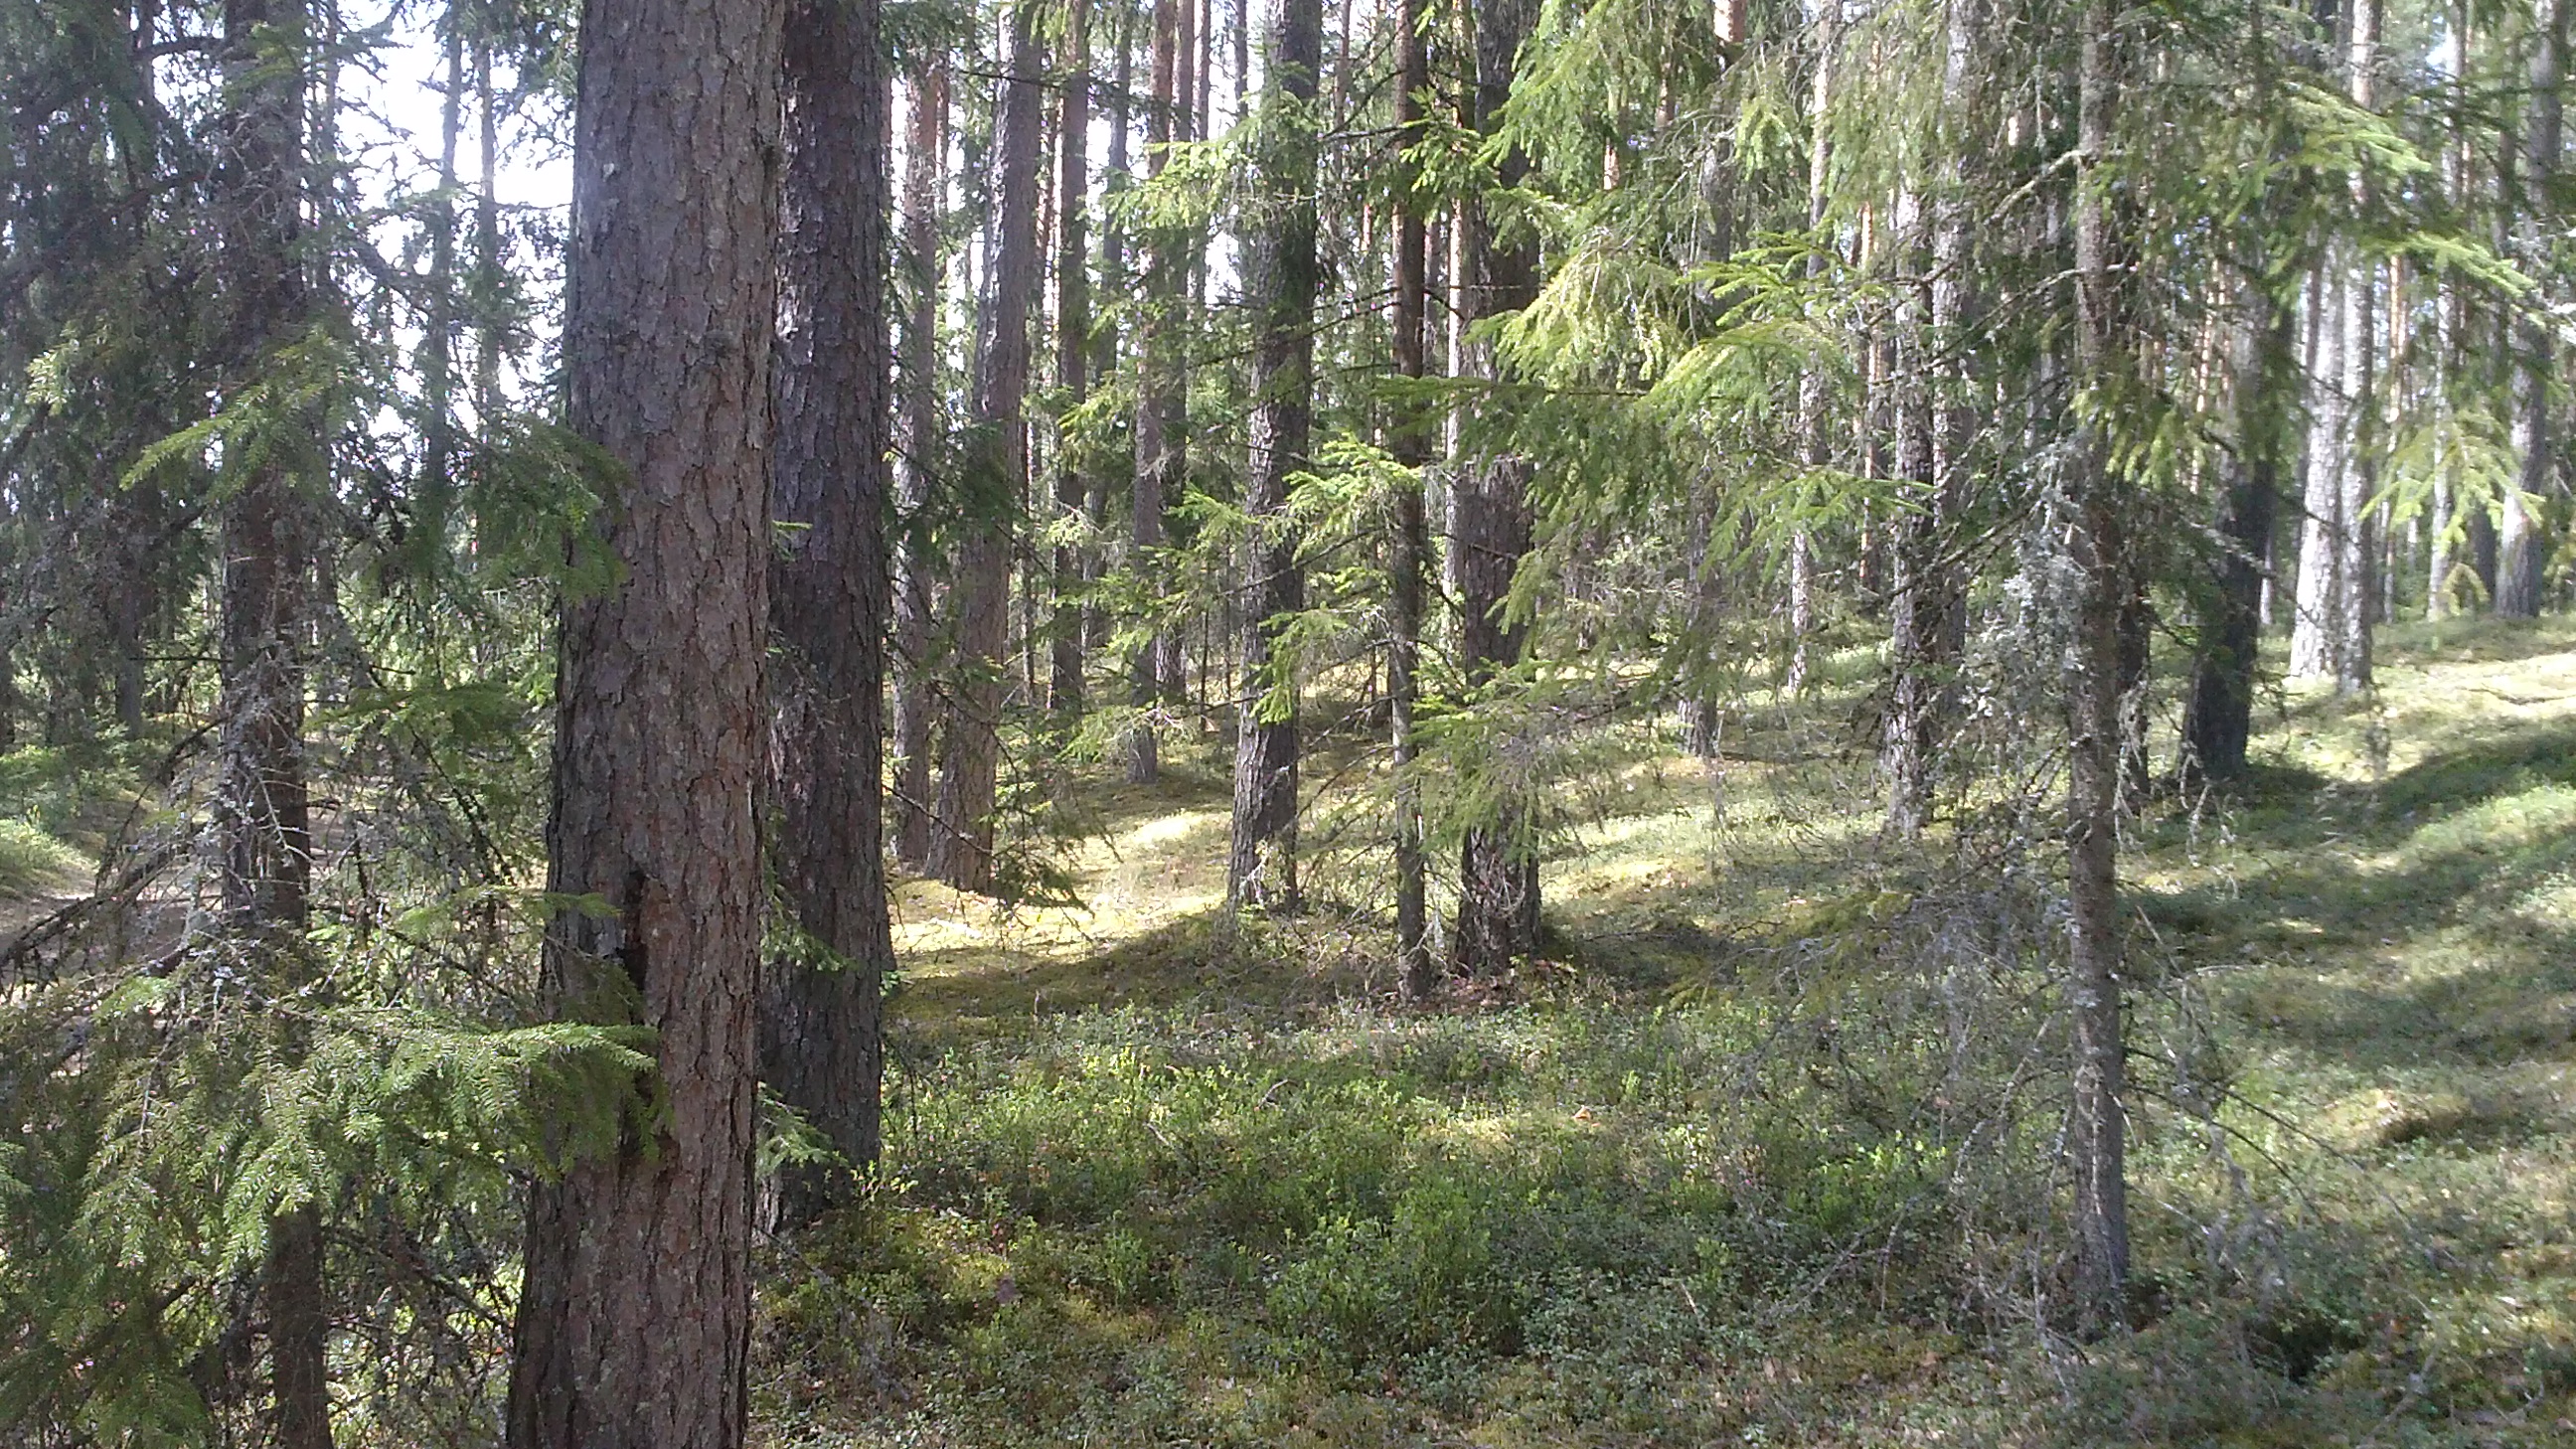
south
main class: Woodland
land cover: Pine dominated coniferous woodland
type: hemiboreal forest and nemoral coniferous forest and mixed broadleaved-coniferous forest
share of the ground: > 75 %
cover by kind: coniferous forest trees 100 %
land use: Forestry
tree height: > 5 m
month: May
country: LV
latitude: 55.8844
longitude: 27.2975
